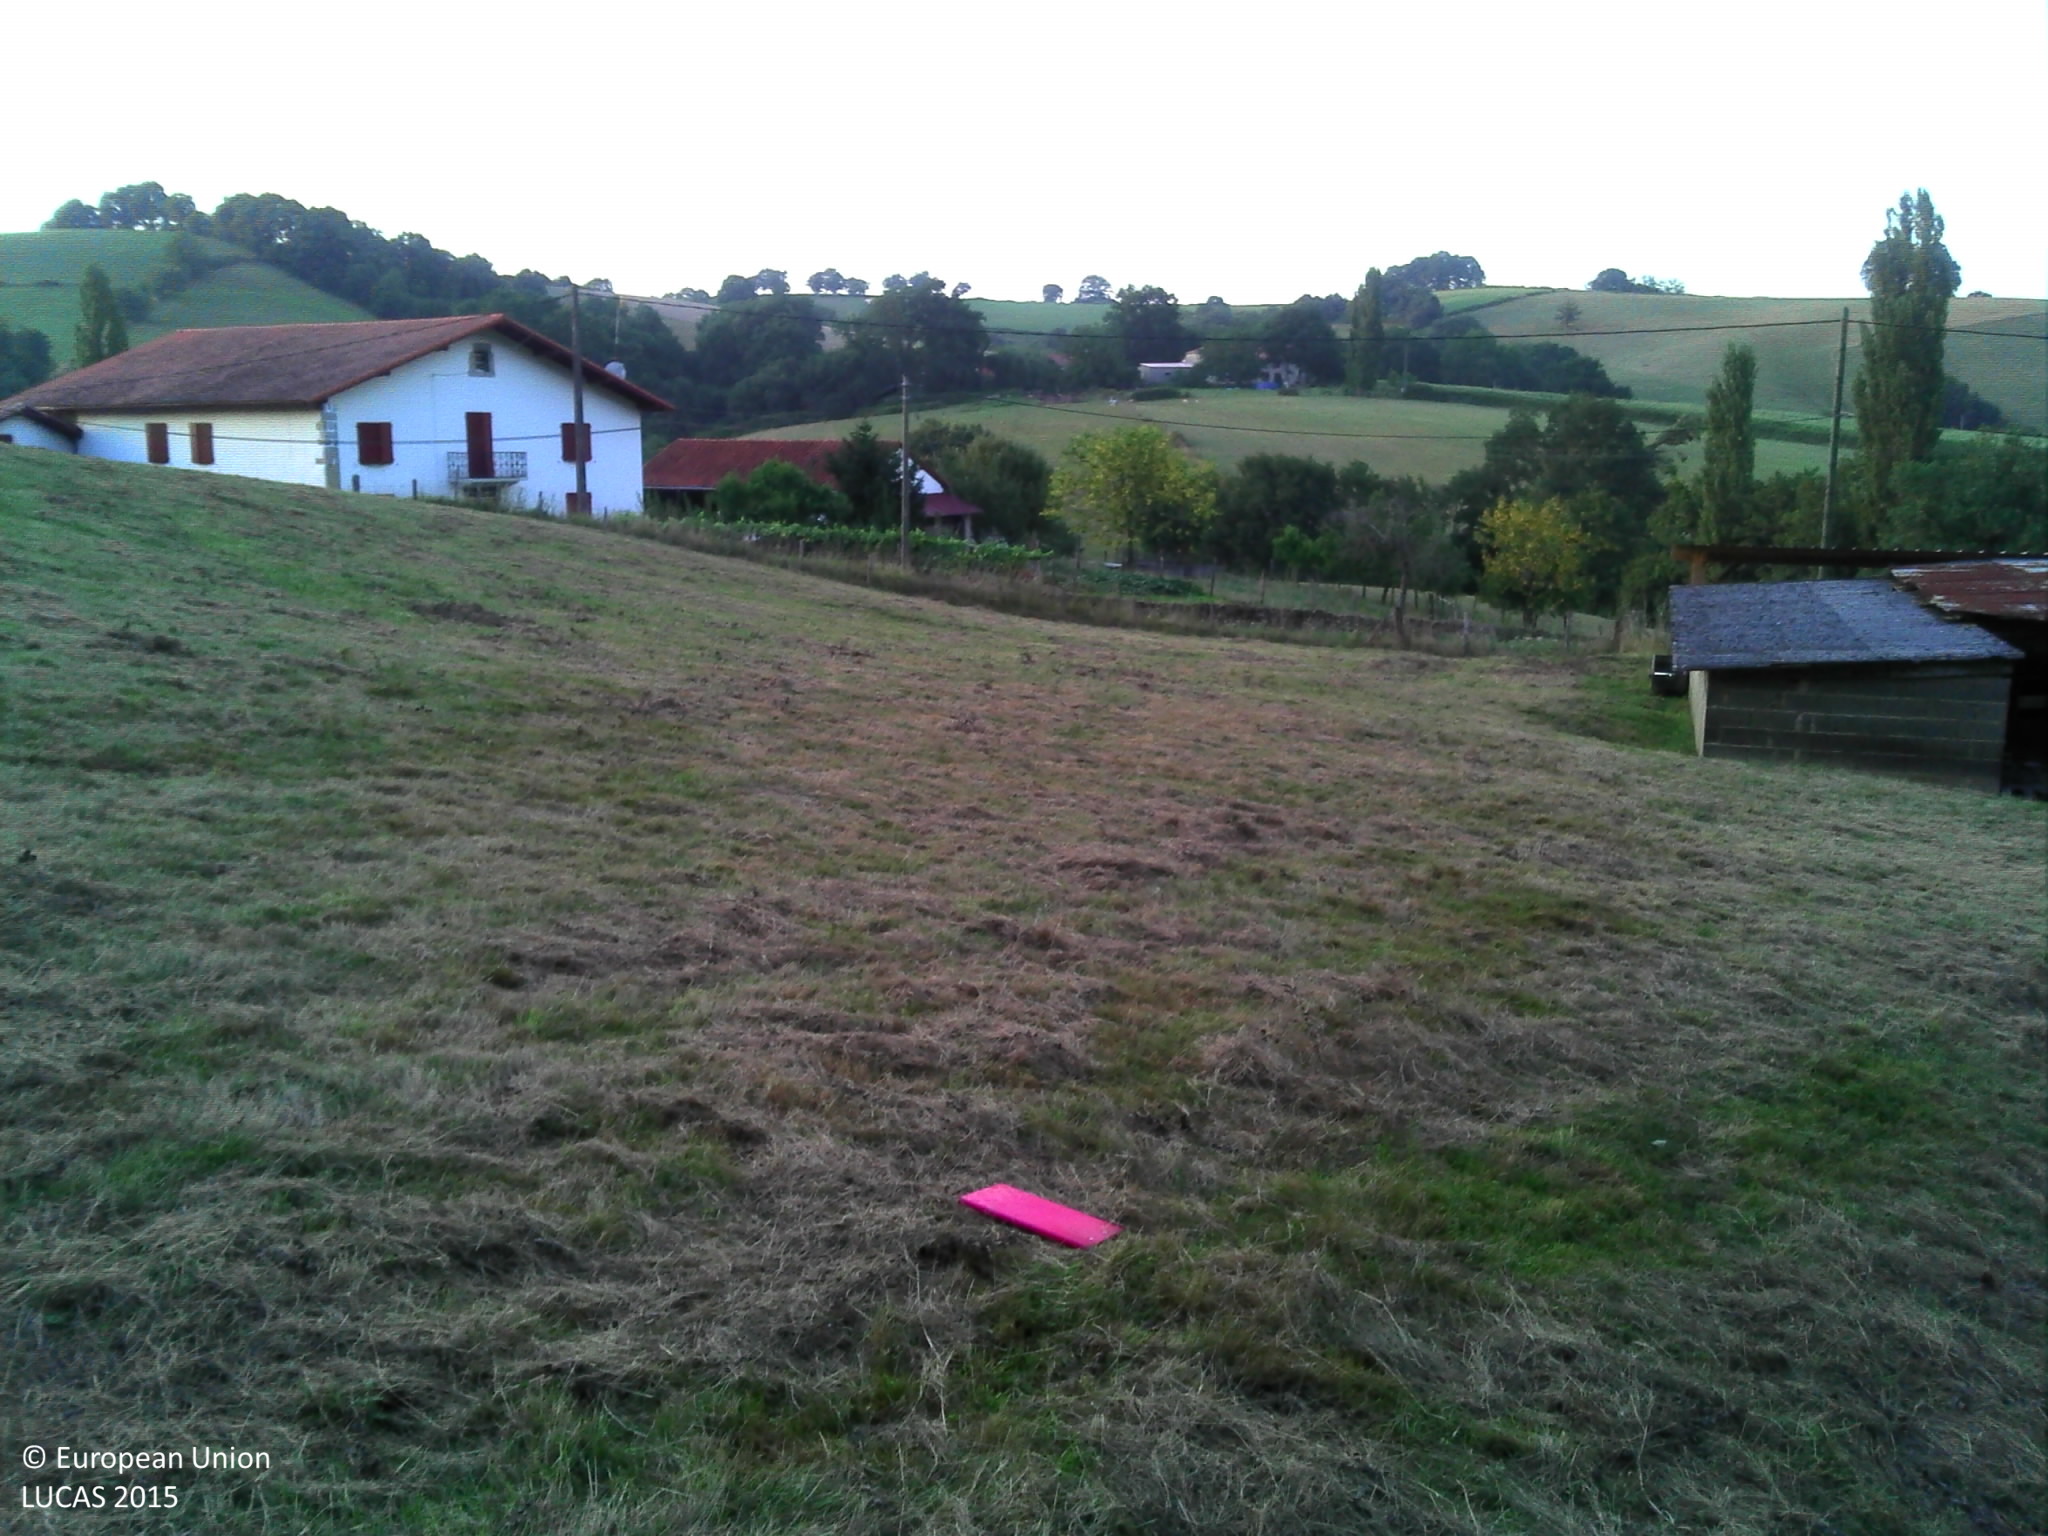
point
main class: Grassland
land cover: Grassland without tree/shrub cover
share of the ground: > 75 %
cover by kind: herbaceous plants 100 %
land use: Agriculture (excluding fallow land and kitchen gardens)
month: August
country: FR
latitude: 43.2783
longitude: -1.1157
